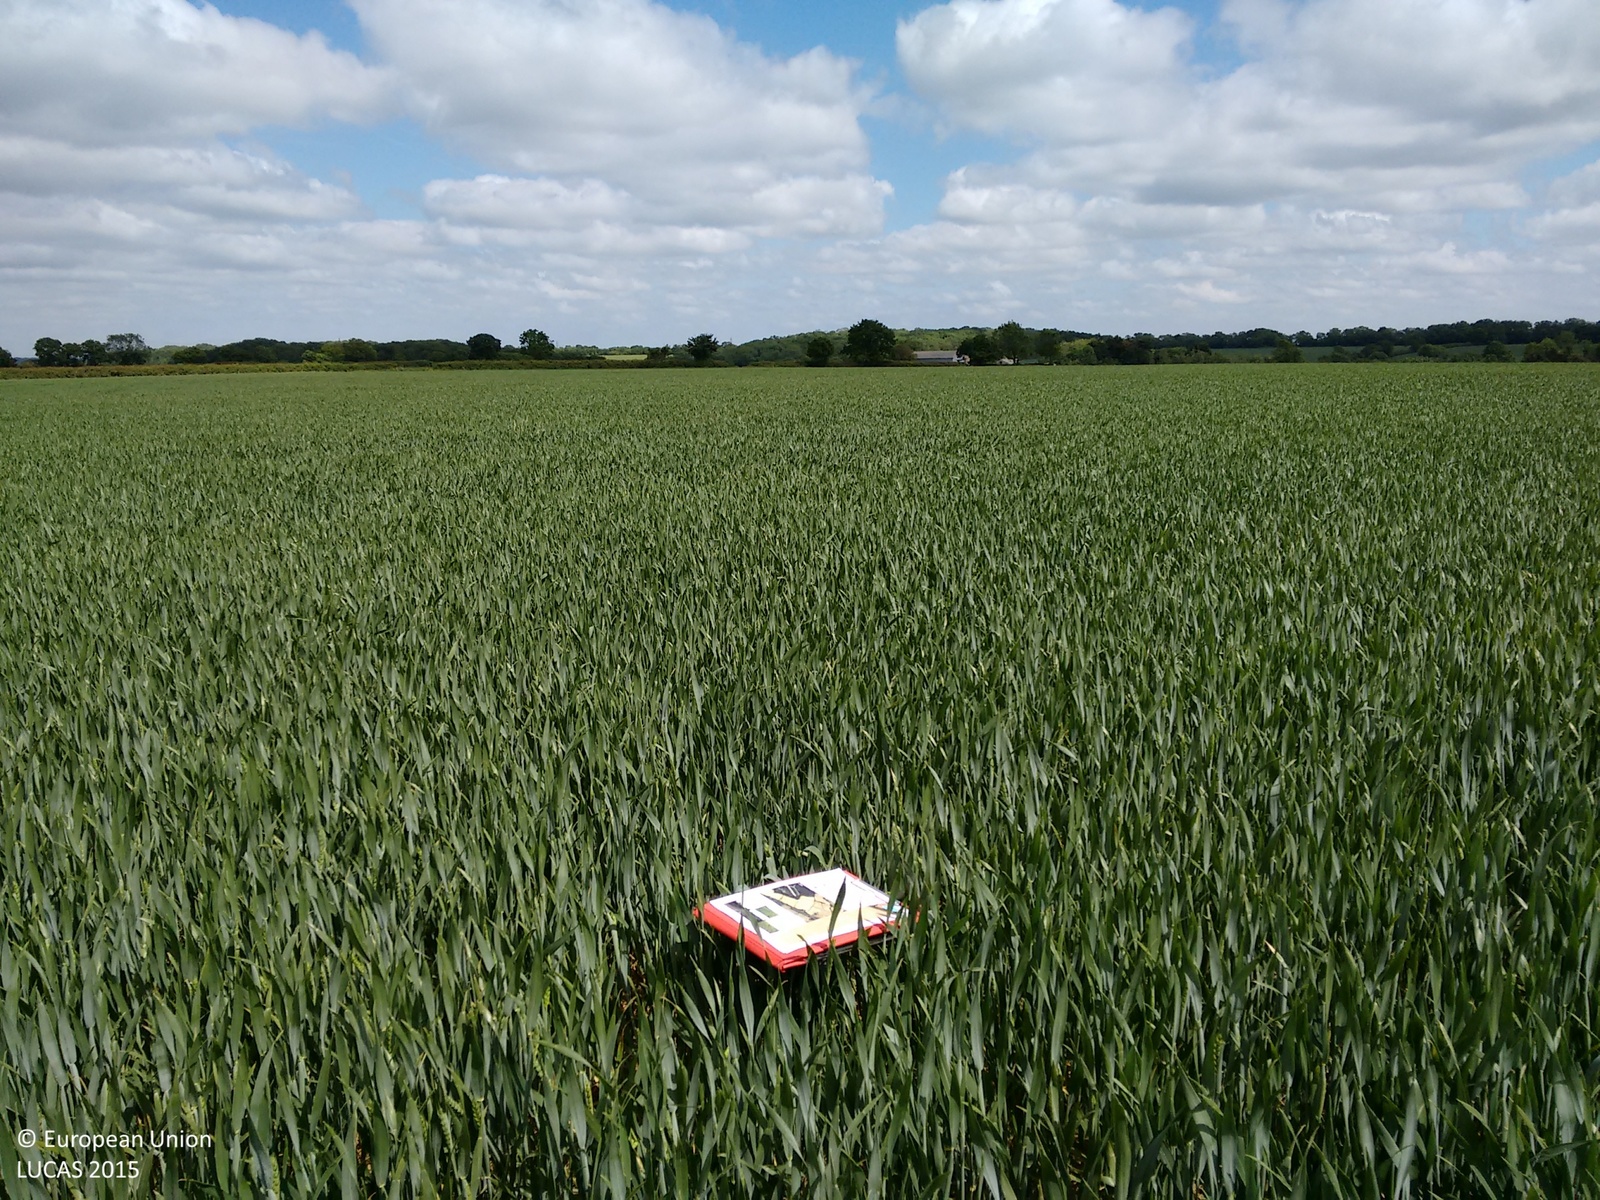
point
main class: Cropland
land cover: Common wheat
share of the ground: > 75 %
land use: Agriculture (excluding fallow land and kitchen gardens)
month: June
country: GB
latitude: 52.7918
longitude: -0.5825
